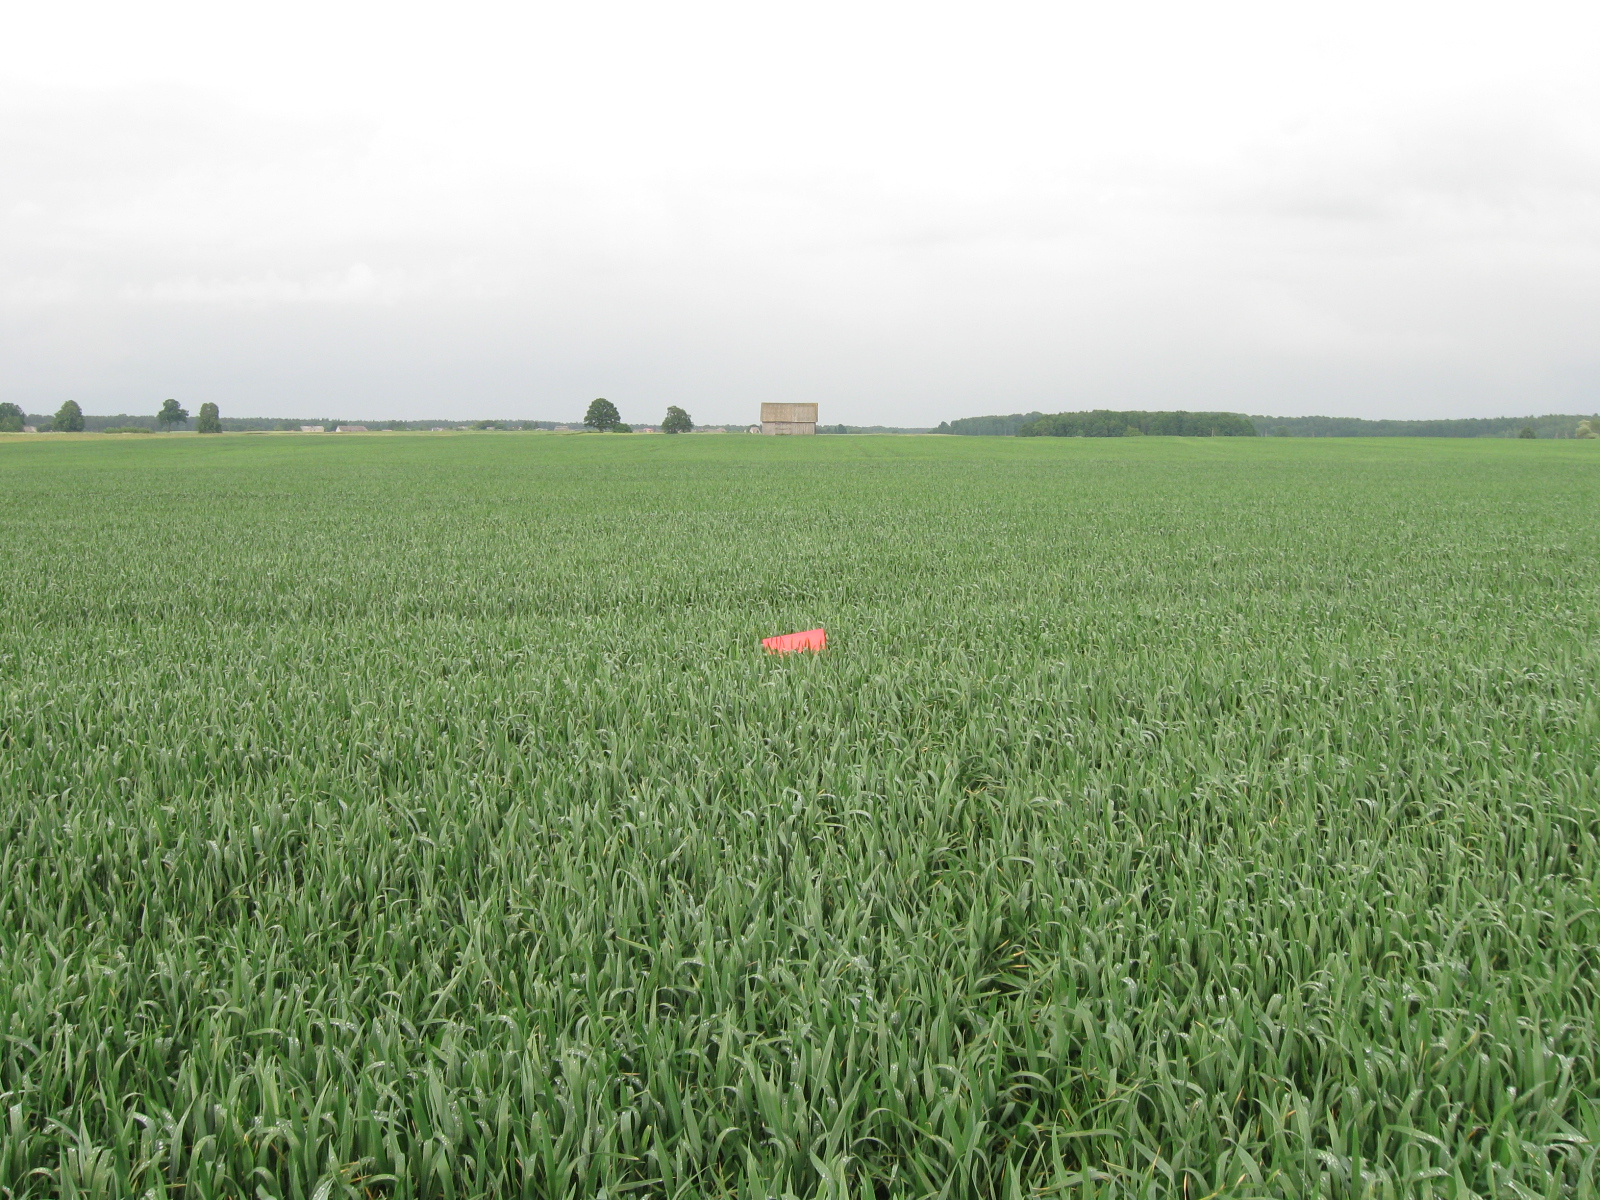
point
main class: Cropland
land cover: Common wheat
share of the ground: > 75 %
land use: Agriculture (excluding fallow land and kitchen gardens)
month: June
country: LT
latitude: 54.9608
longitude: 24.4535
